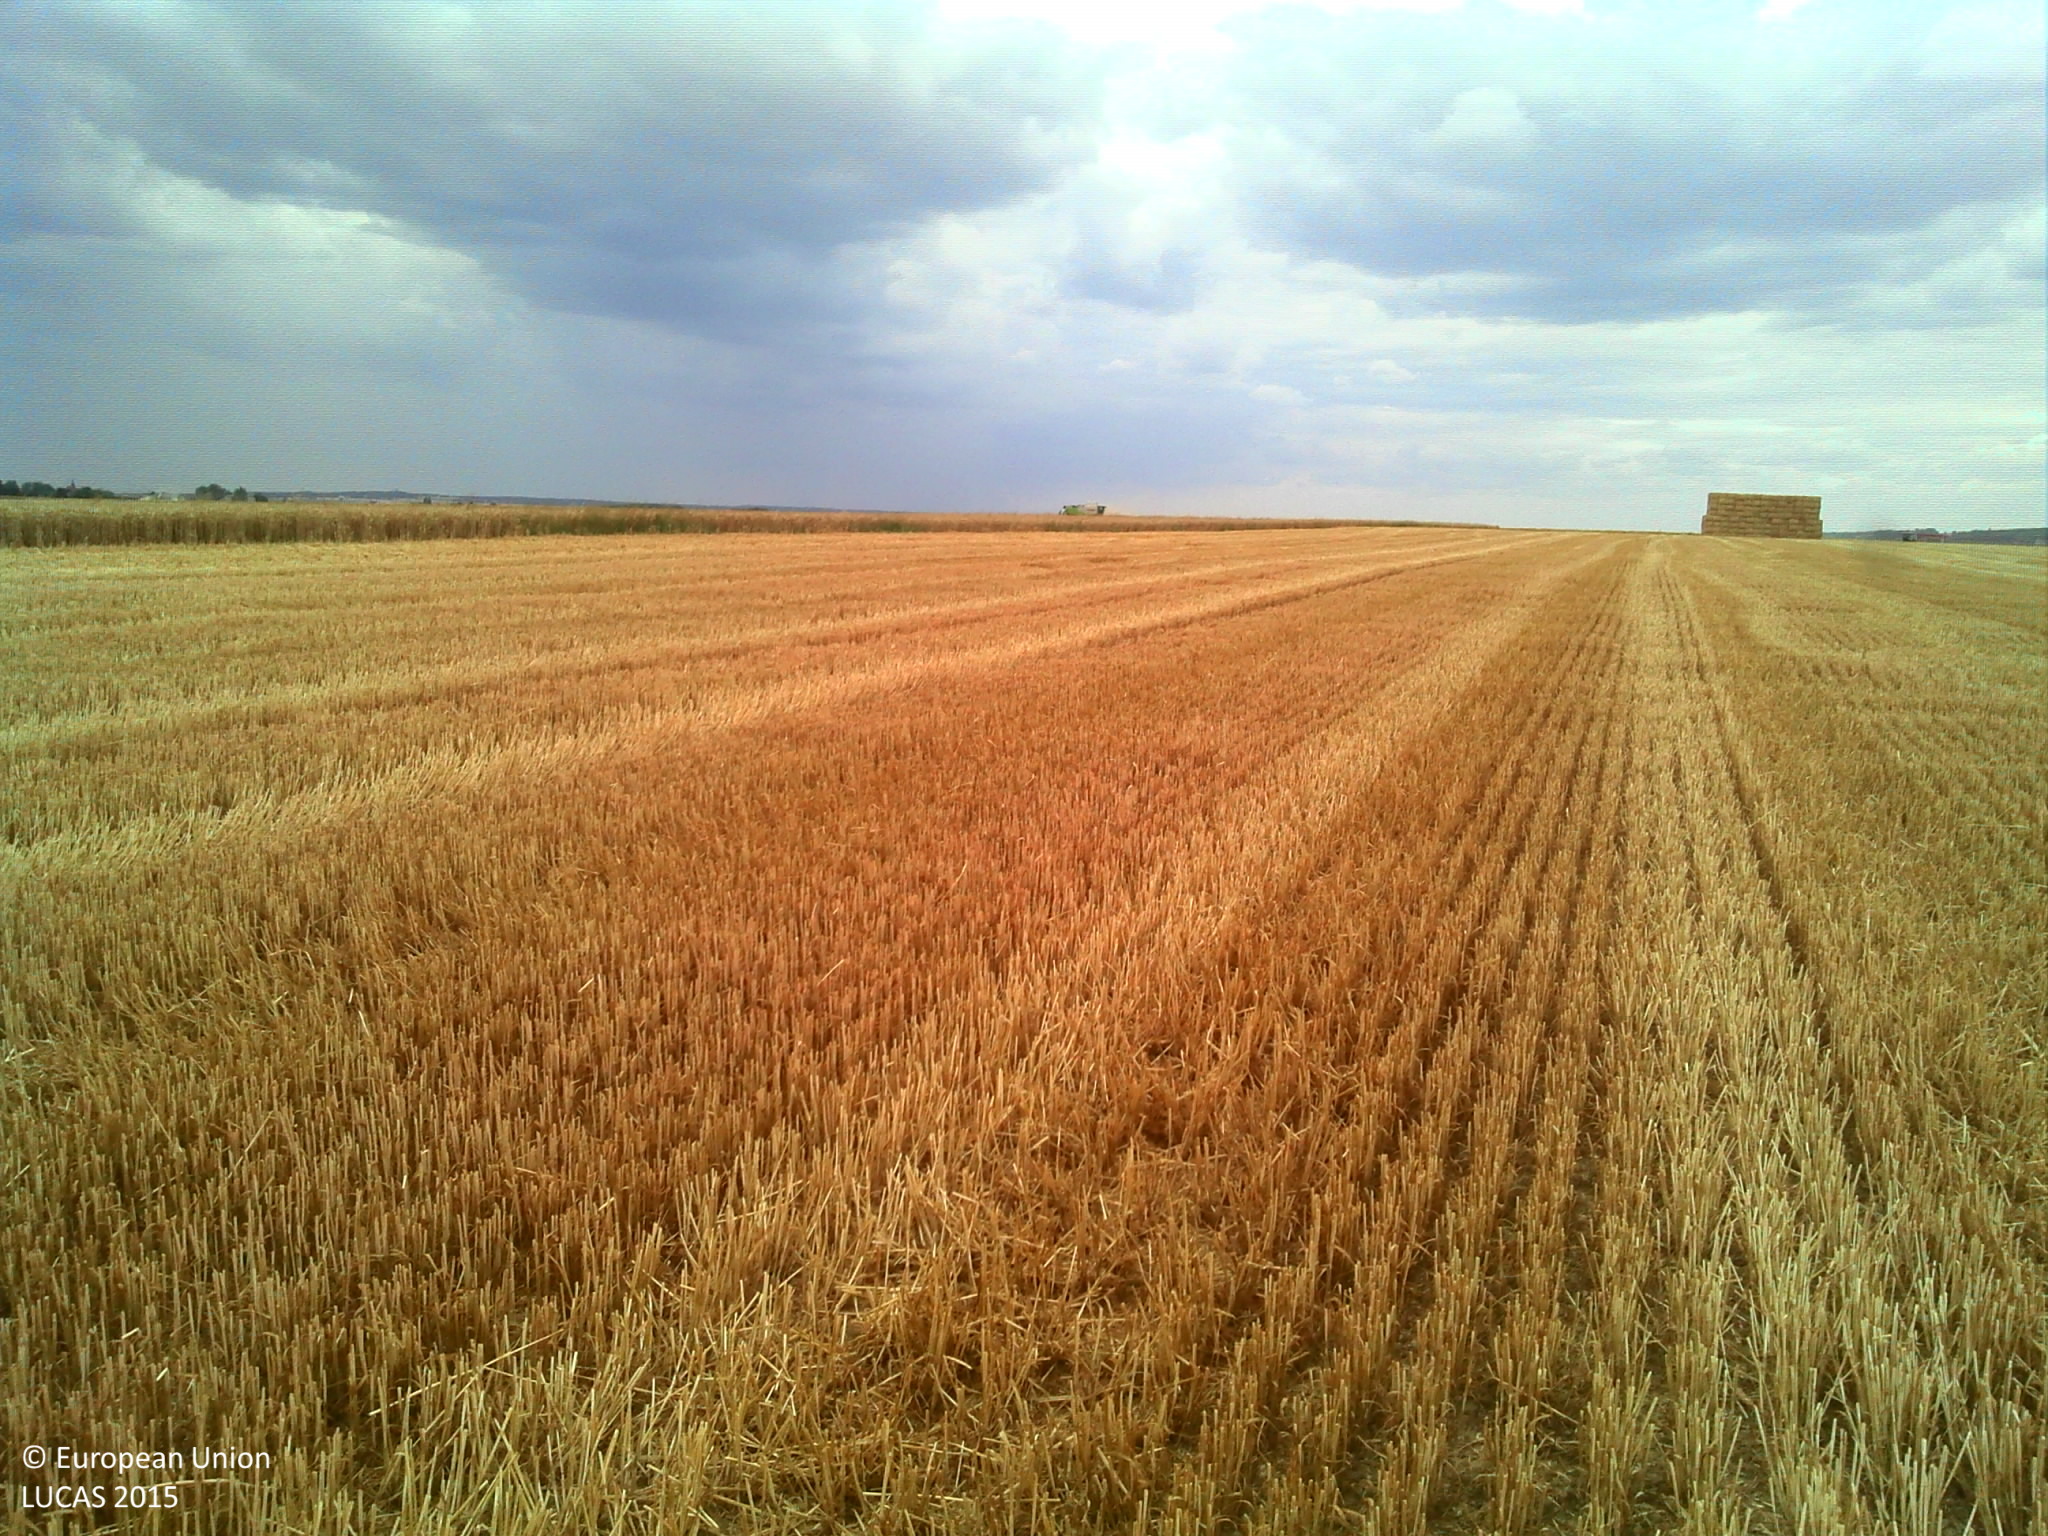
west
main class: Cropland
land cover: Common wheat
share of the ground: > 75 %
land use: Agriculture (excluding fallow land and kitchen gardens)
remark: Harvested field
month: July
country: FR
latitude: 48.4907
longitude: 1.2537
